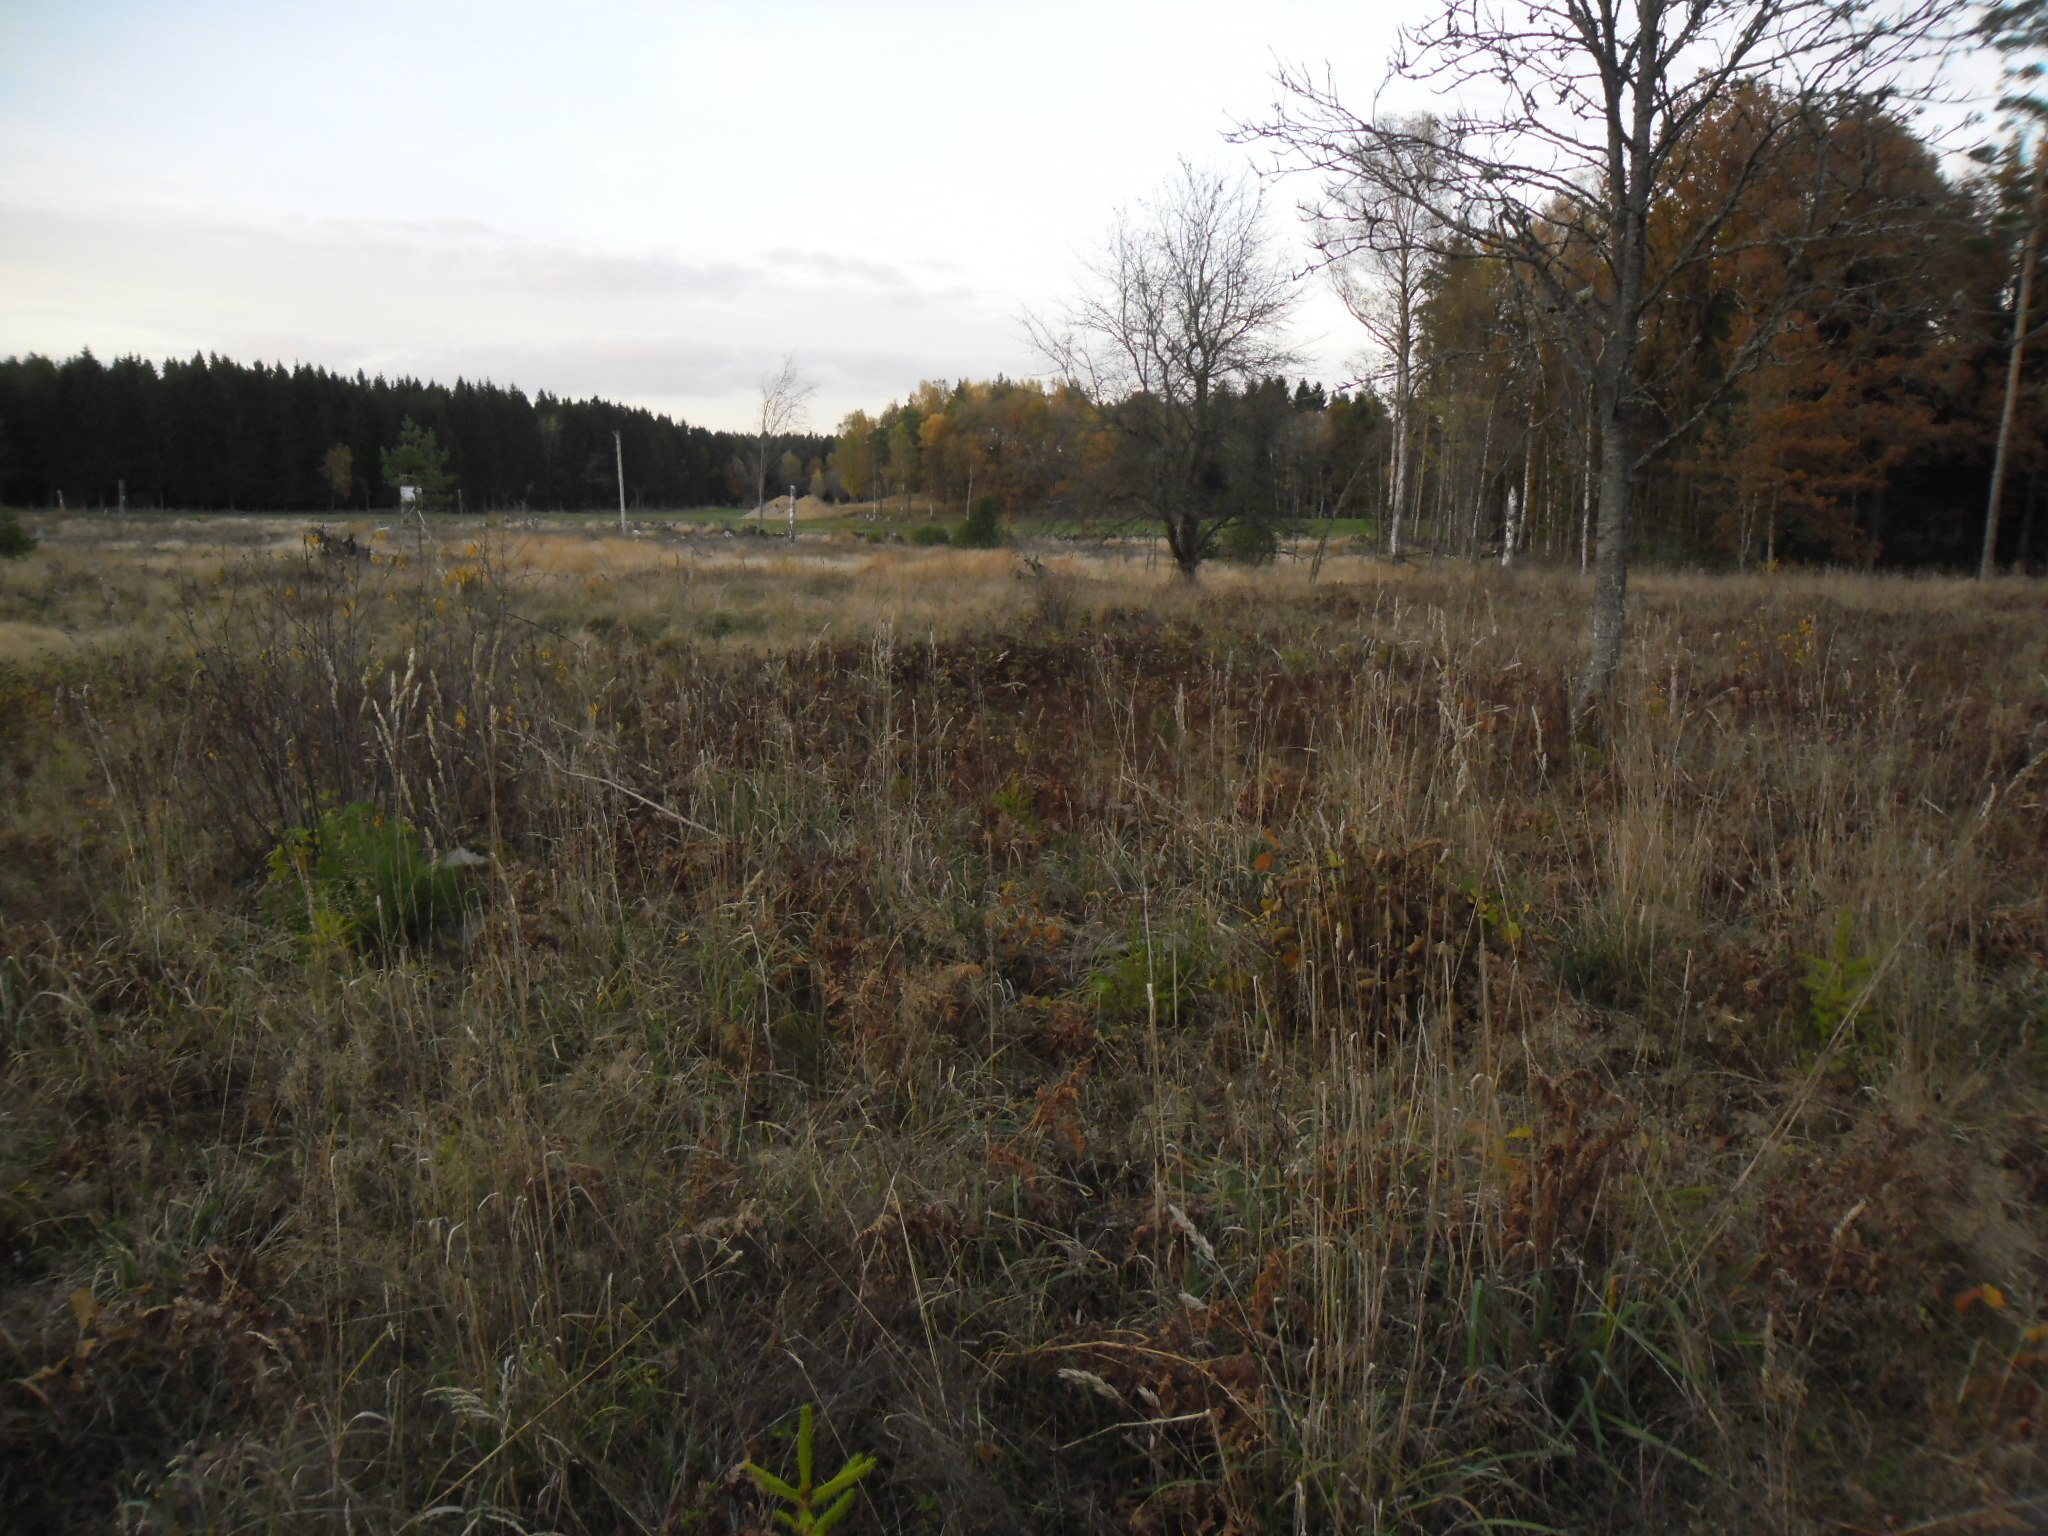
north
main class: Grassland
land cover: Grassland without tree/shrub cover
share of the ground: > 75 %
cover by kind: herbaceous plants 100 %
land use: Agriculture (excluding fallow land and kitchen gardens)
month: October
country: SE
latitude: 56.2229
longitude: 13.7552
